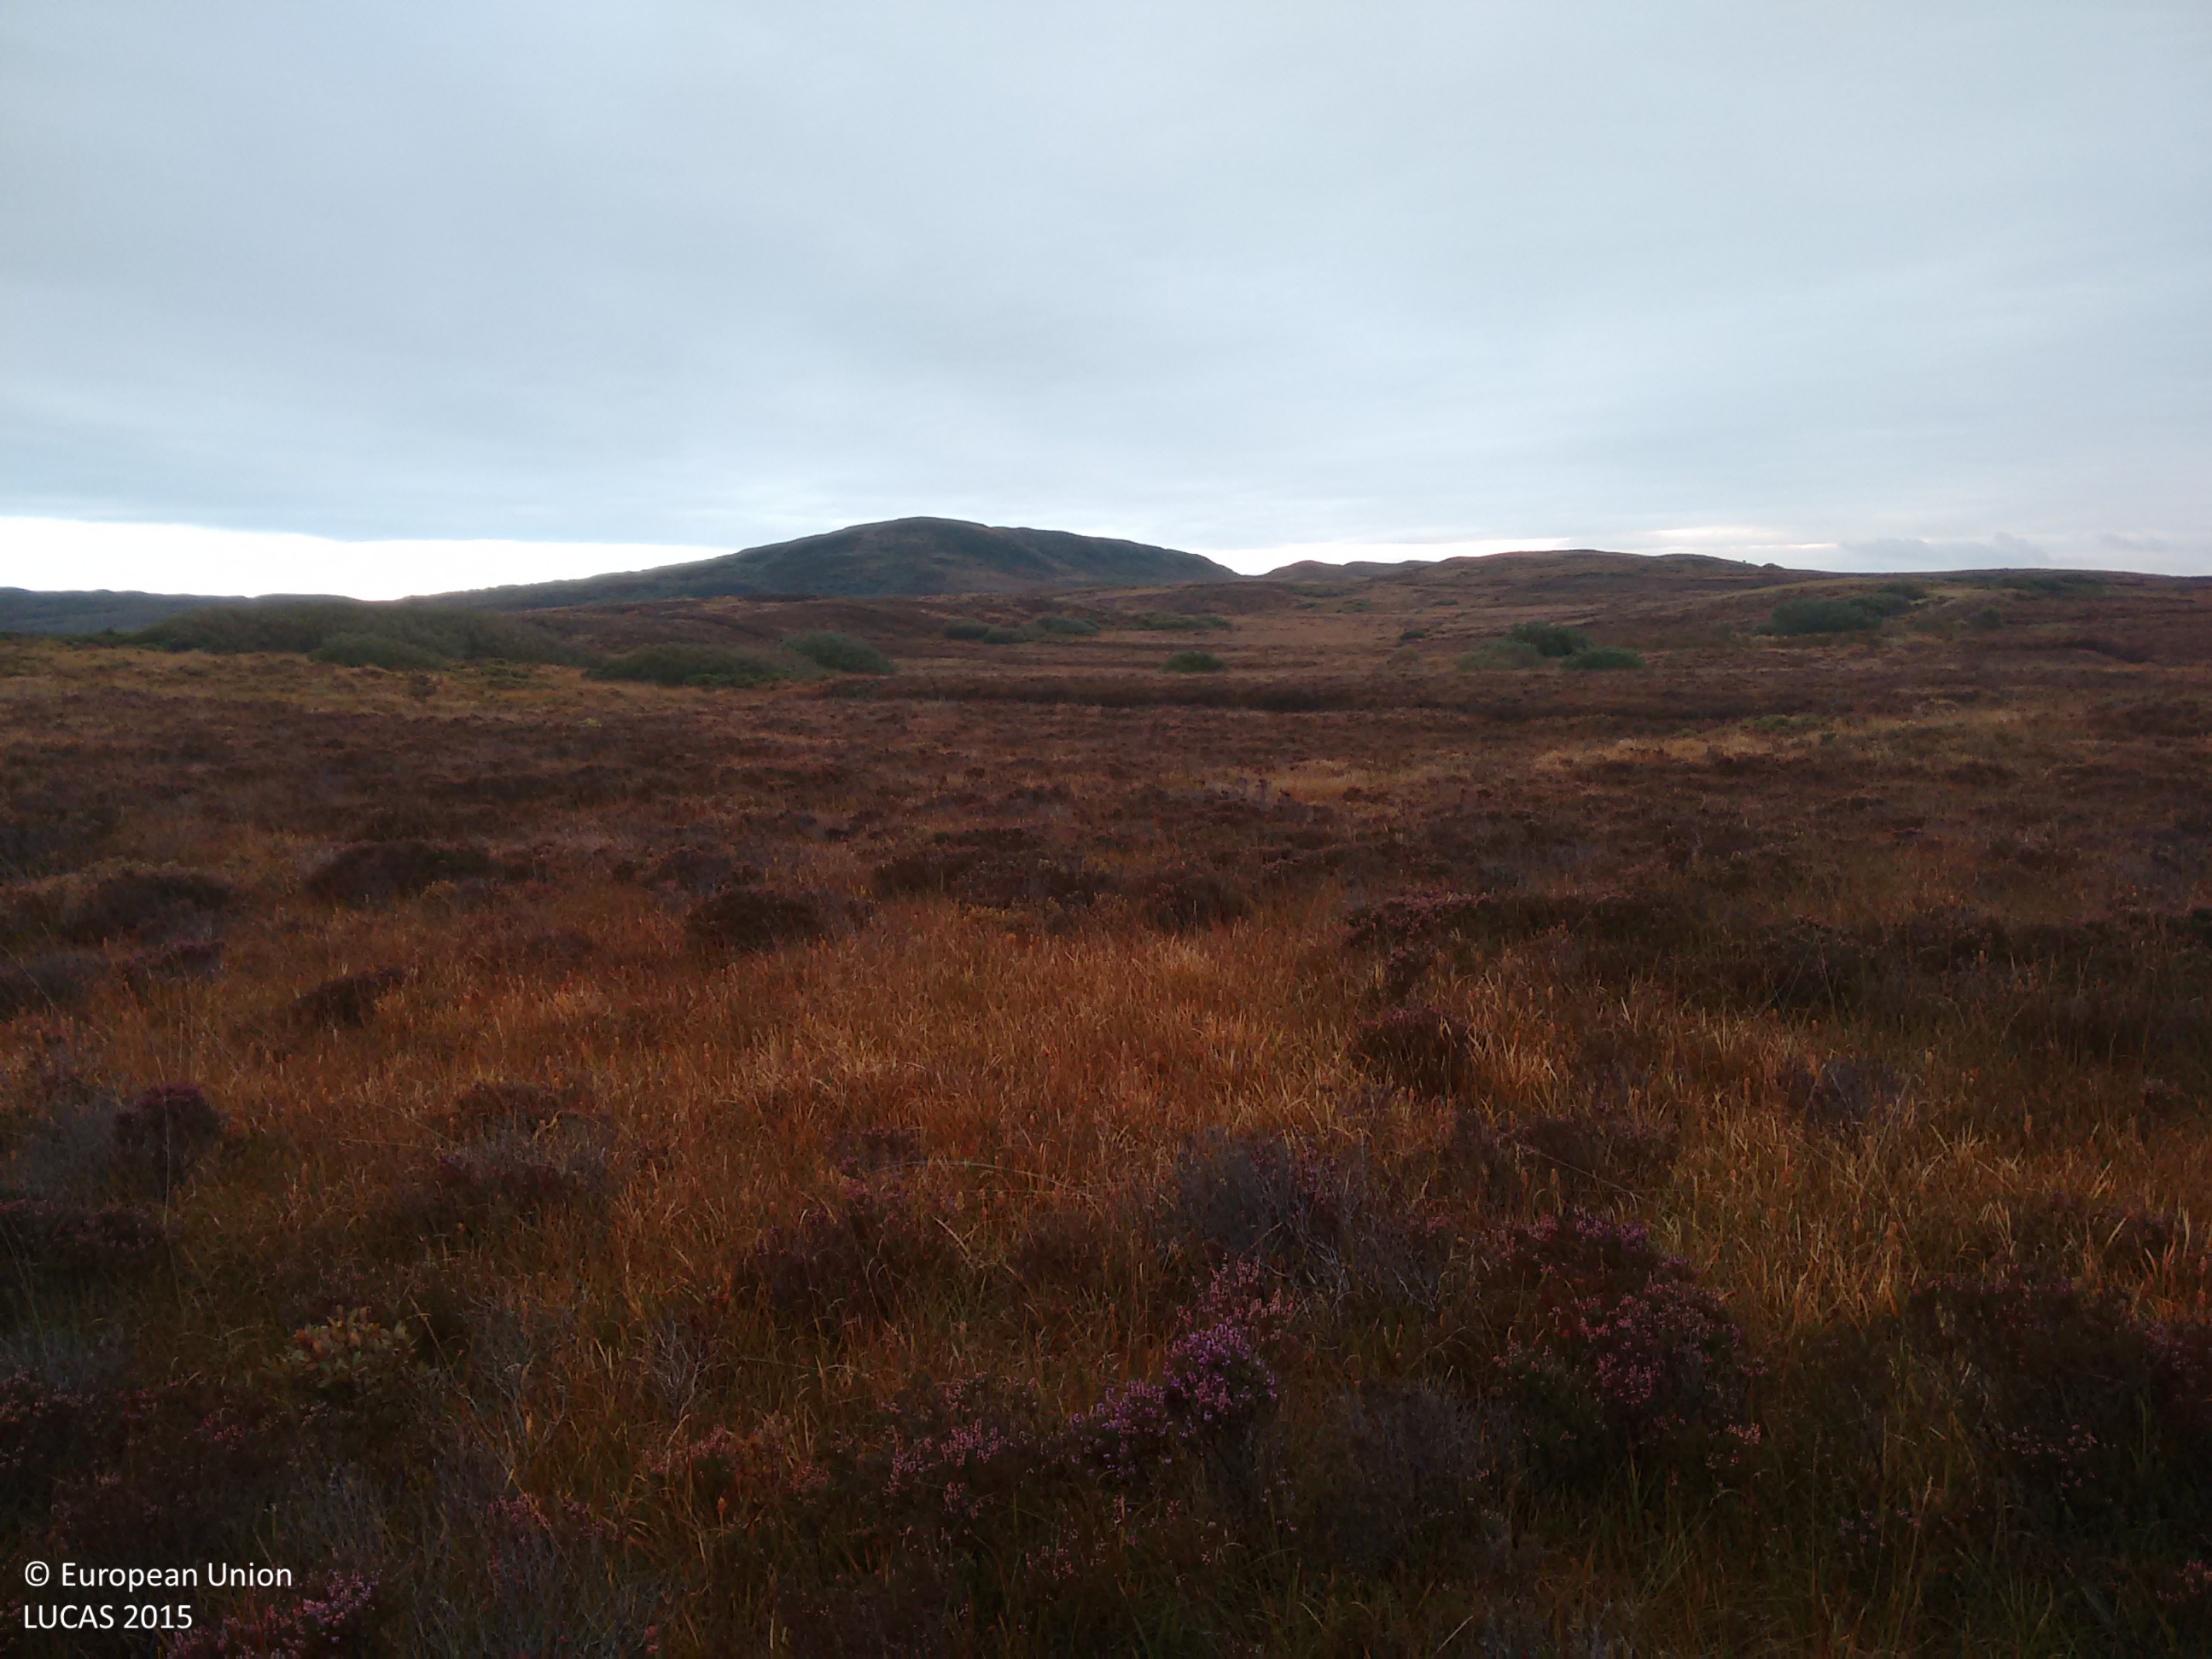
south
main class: Shrubland
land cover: Shrubland without tree cover
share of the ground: > 75 %
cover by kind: shrubs 80 %, herbaceous plants 10 %, lichens and mosses 10 %
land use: Agriculture (excluding fallow land and kitchen gardens)
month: October
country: GB
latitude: 55.8729
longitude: -6.1385
